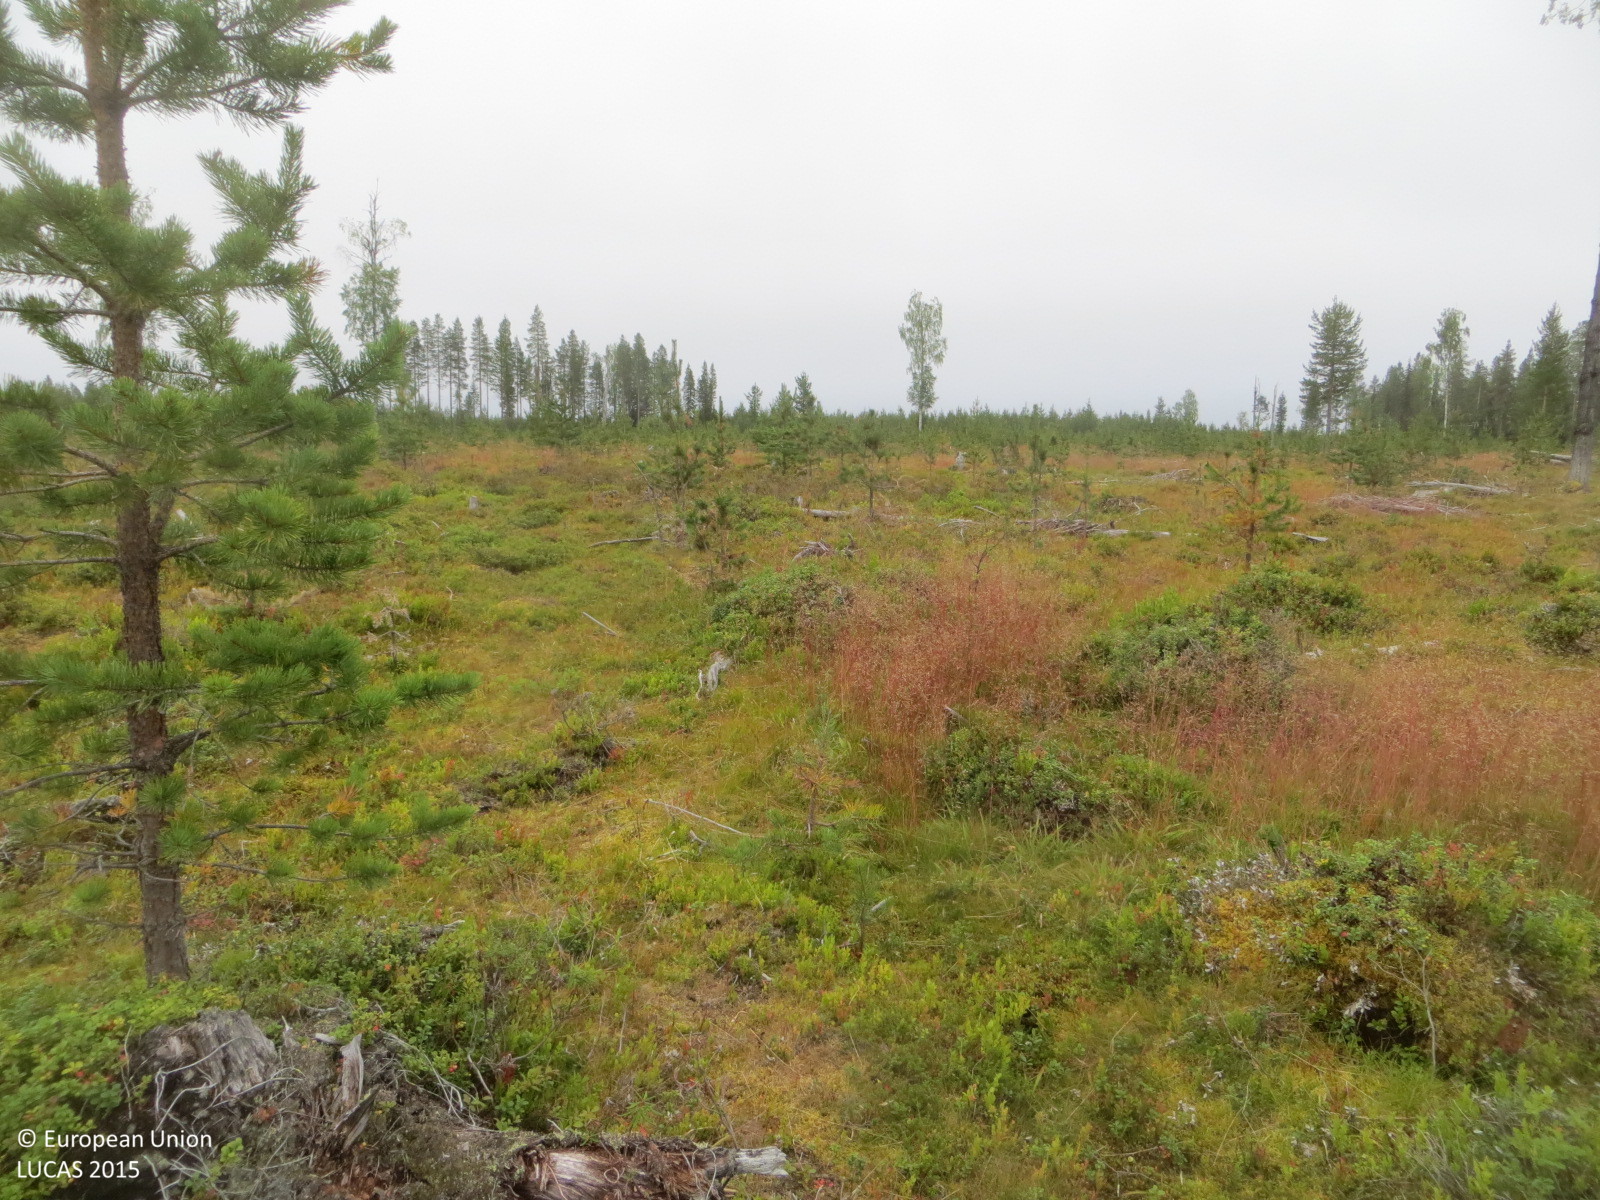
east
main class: Woodland
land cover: Pine dominated coniferous woodland
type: boreal forest
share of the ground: 10 - 25 %
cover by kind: shrubs 80 %, coniferous forest trees 20 %
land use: Forestry
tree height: < 5 m
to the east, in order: Pine dominated coniferous woodland
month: August
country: FI
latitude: 67.3254
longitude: 24.7521
